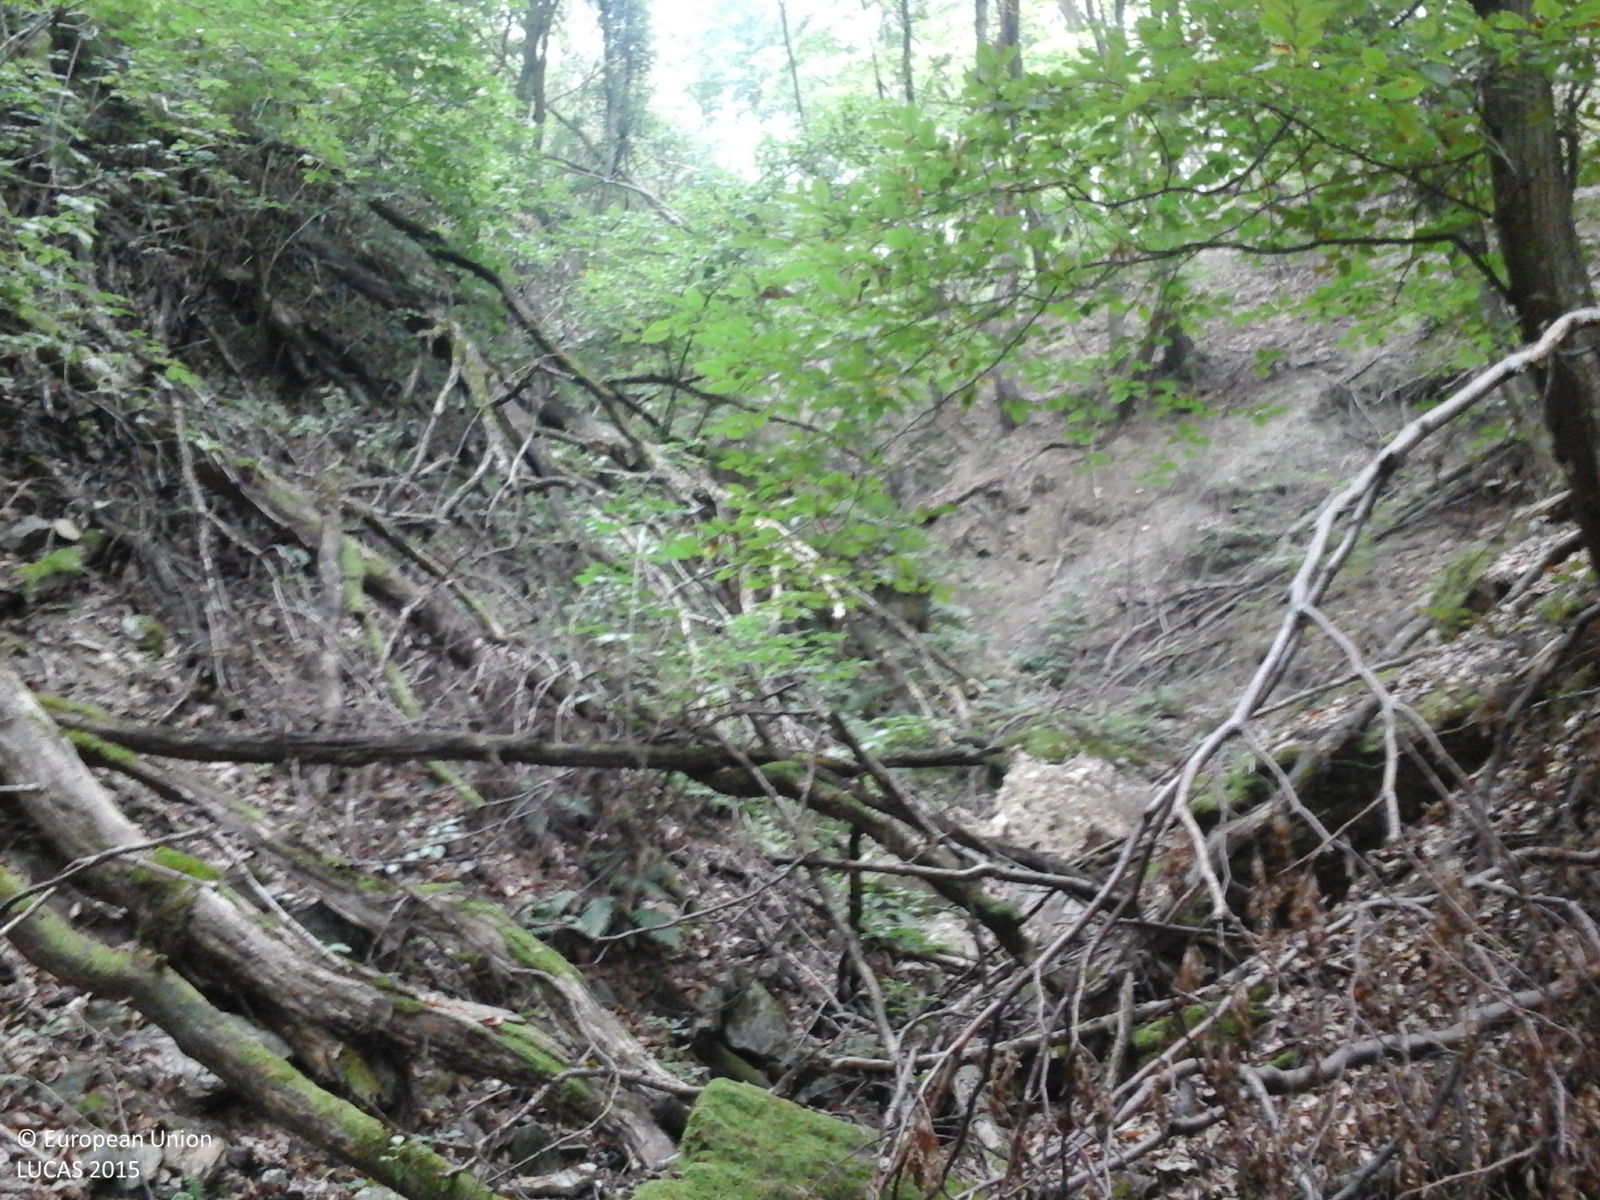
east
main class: Woodland
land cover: Broadleaved woodland
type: mesophytic deciduous forest
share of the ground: > 75 %
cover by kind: broadleaved forest trees 100 %
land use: Forestry
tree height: > 5 m
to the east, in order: Broadleaved woodland
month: September
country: RO
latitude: 45.9033
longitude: 22.8268
